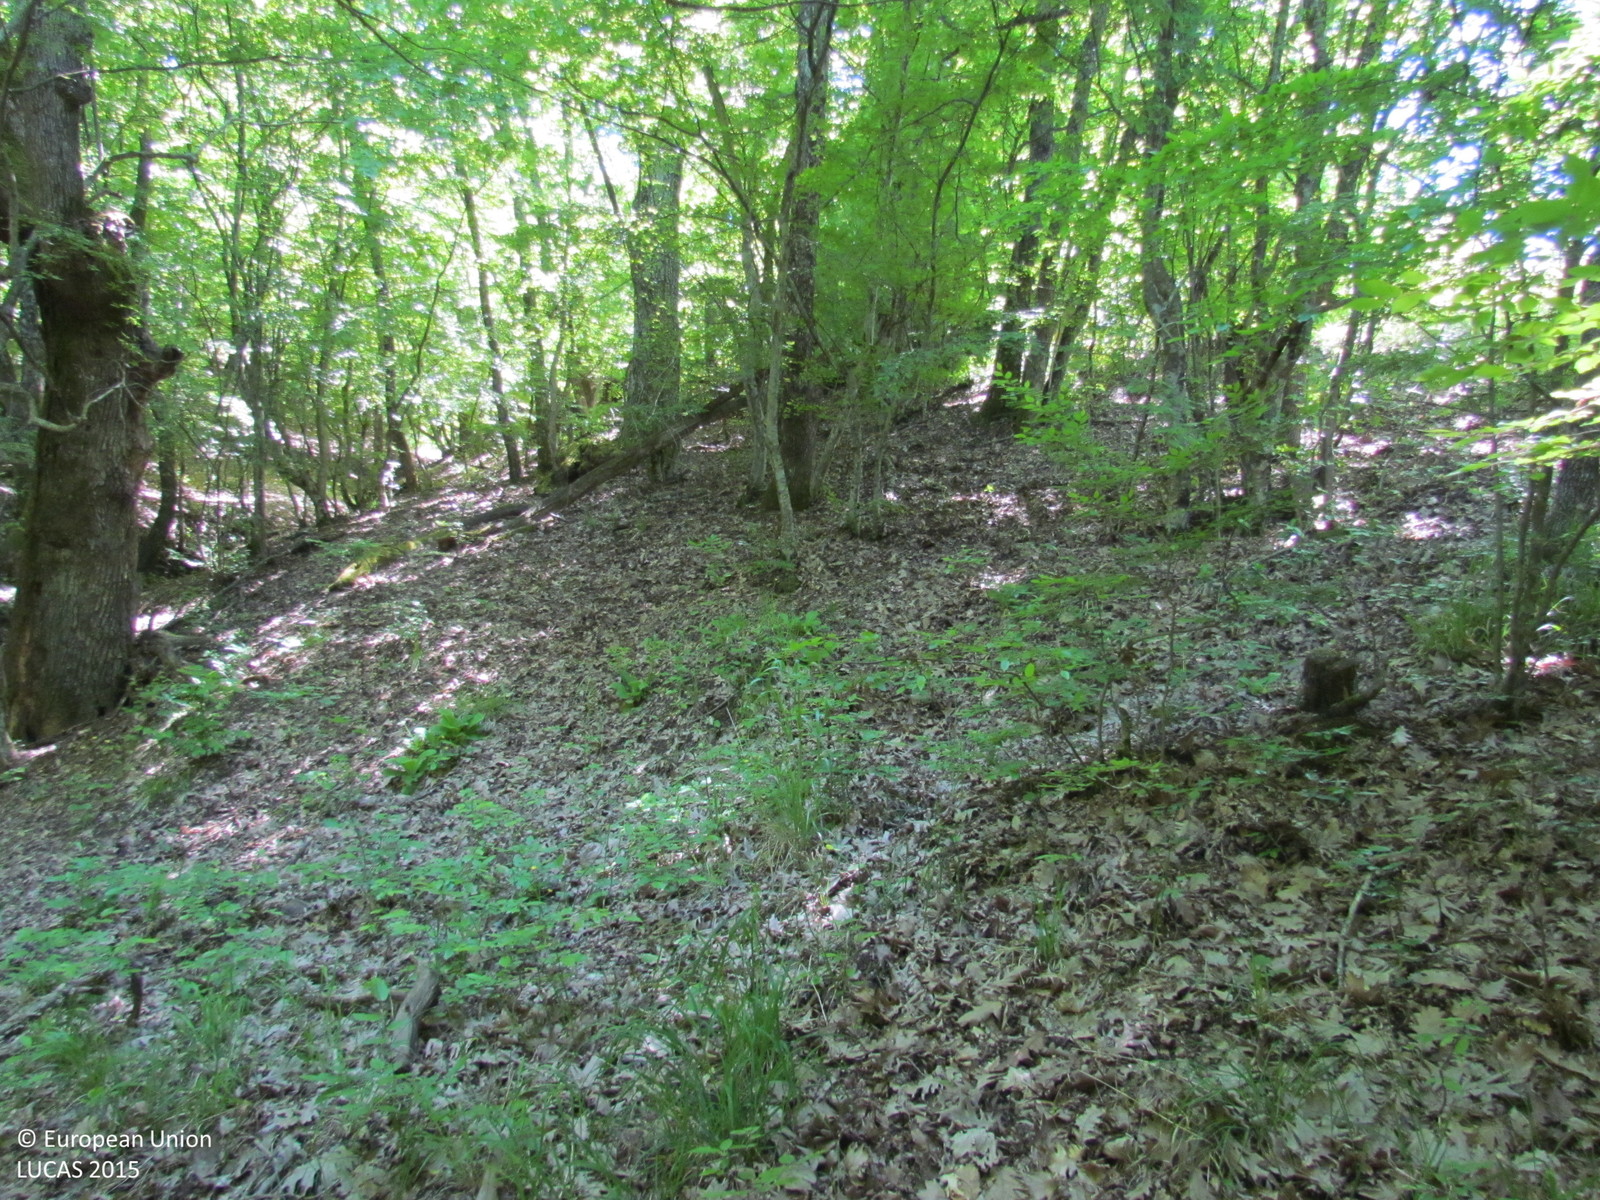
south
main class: Woodland
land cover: Broadleaved woodland
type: mesophytic deciduous forest
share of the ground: > 75 %
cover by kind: broadleaved forest trees 90 %, unconsolidated bare surface 10 %
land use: Forestry
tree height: > 5 m
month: May
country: BG
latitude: 42.1318
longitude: 27.5965
